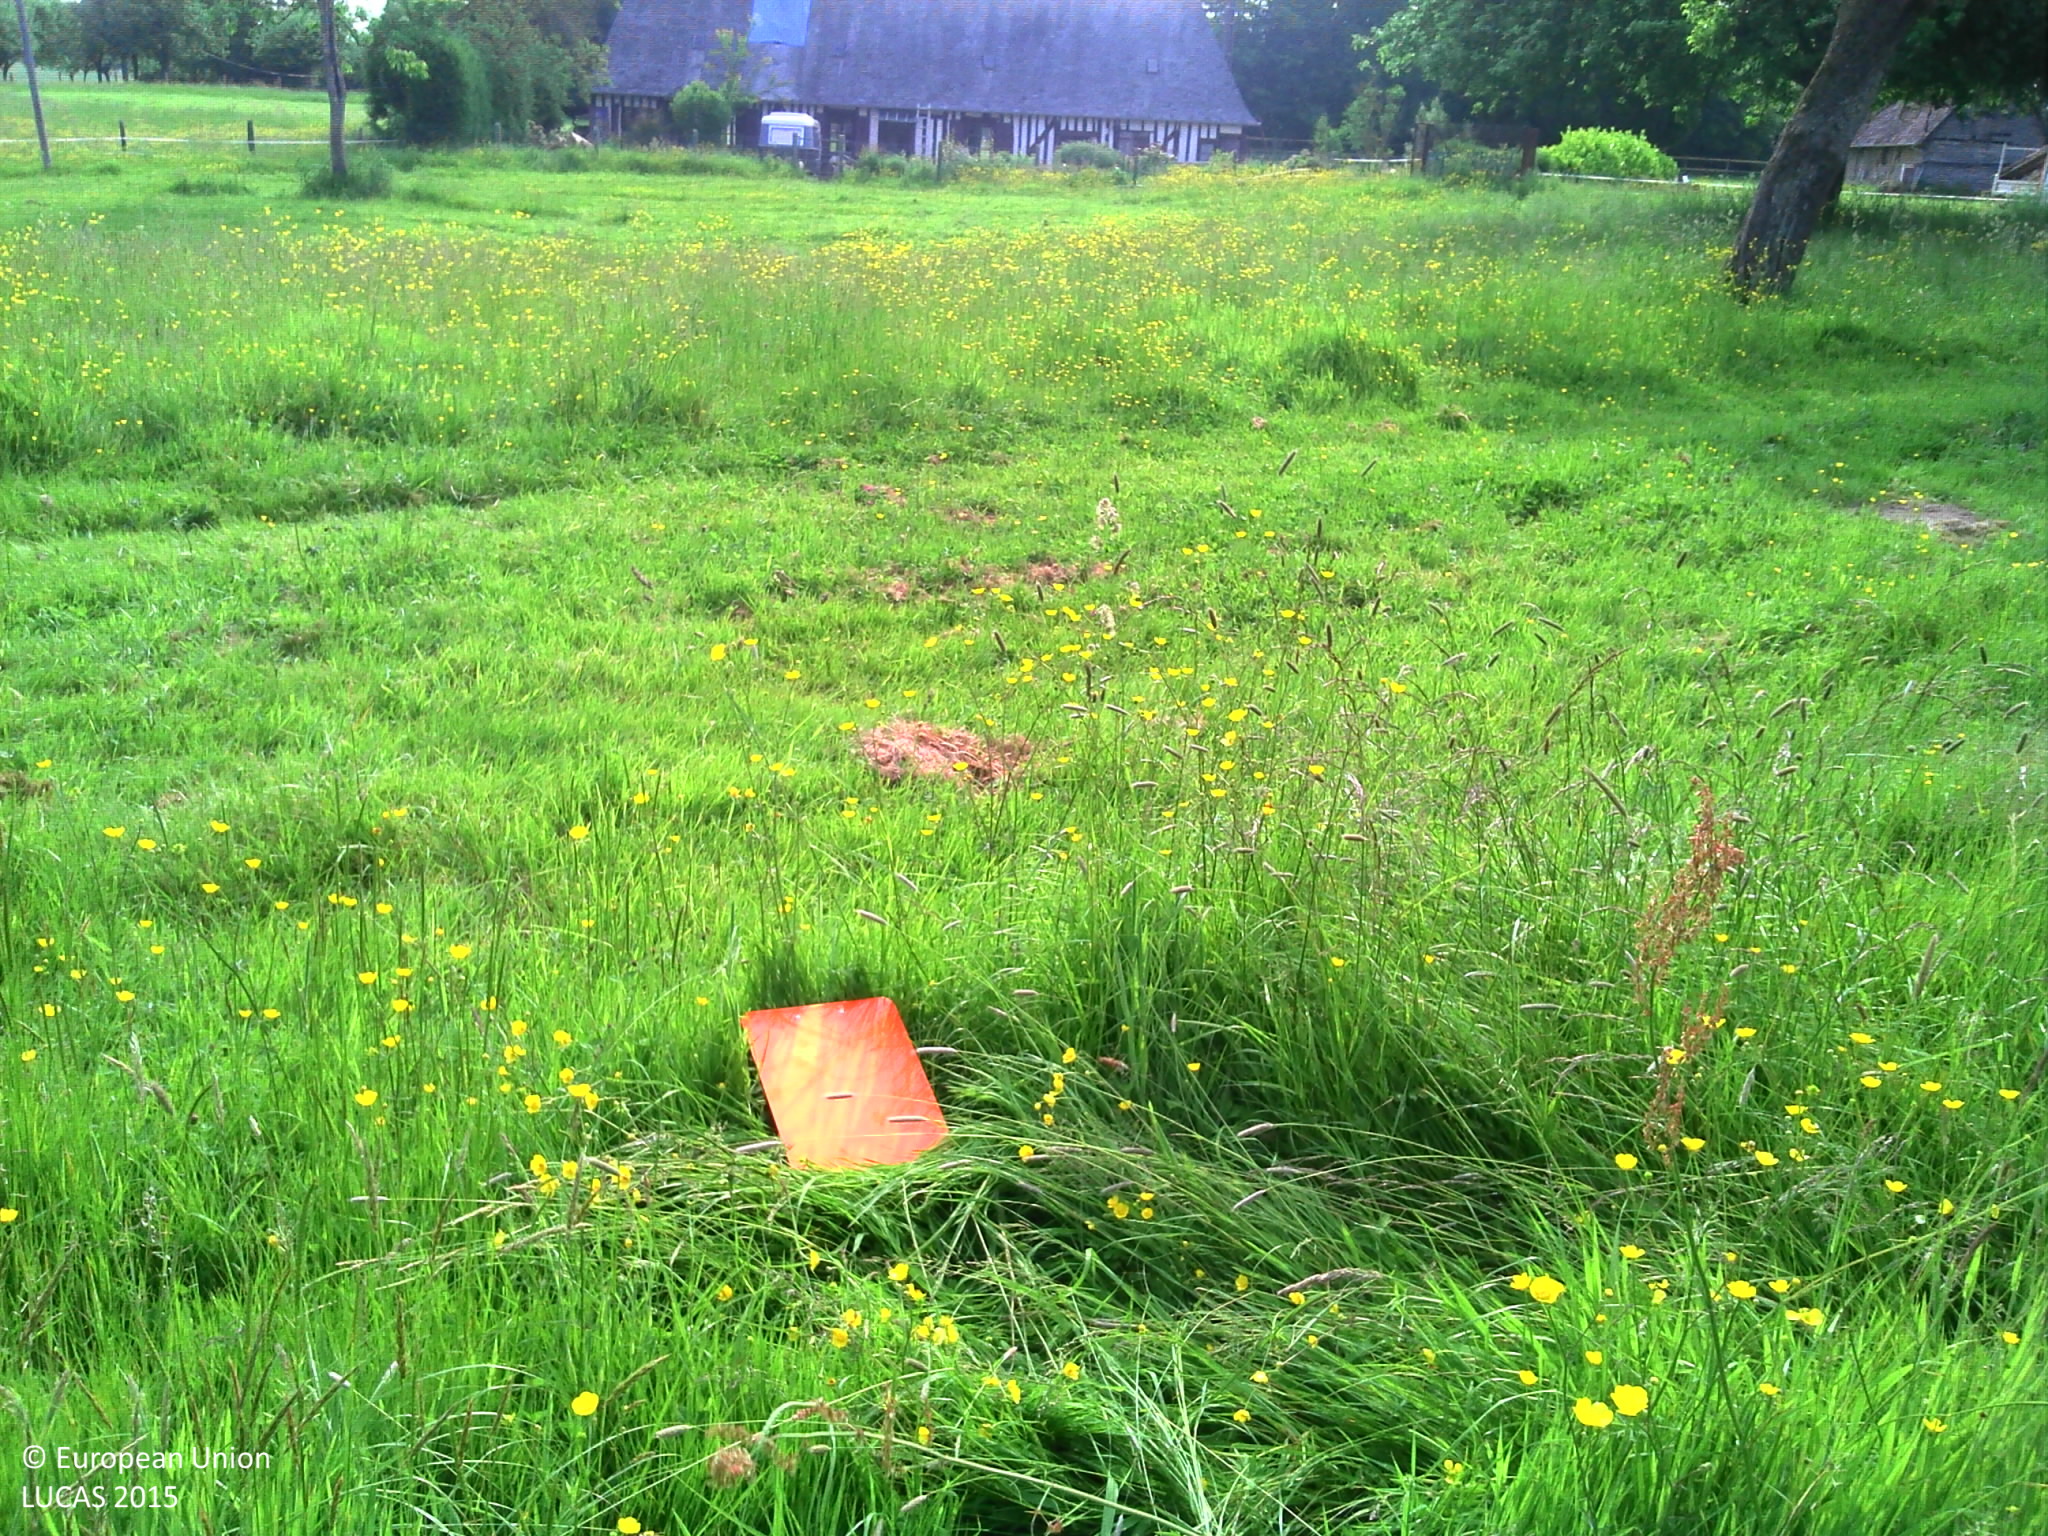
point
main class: Cropland
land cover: Apple fruit
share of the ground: 25 - 50 %
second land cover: Grassland without tree/shrub cover
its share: 50 - 75 %
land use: Agriculture (excluding fallow land and kitchen gardens)
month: June
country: FR
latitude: 49.1970
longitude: 0.3801
